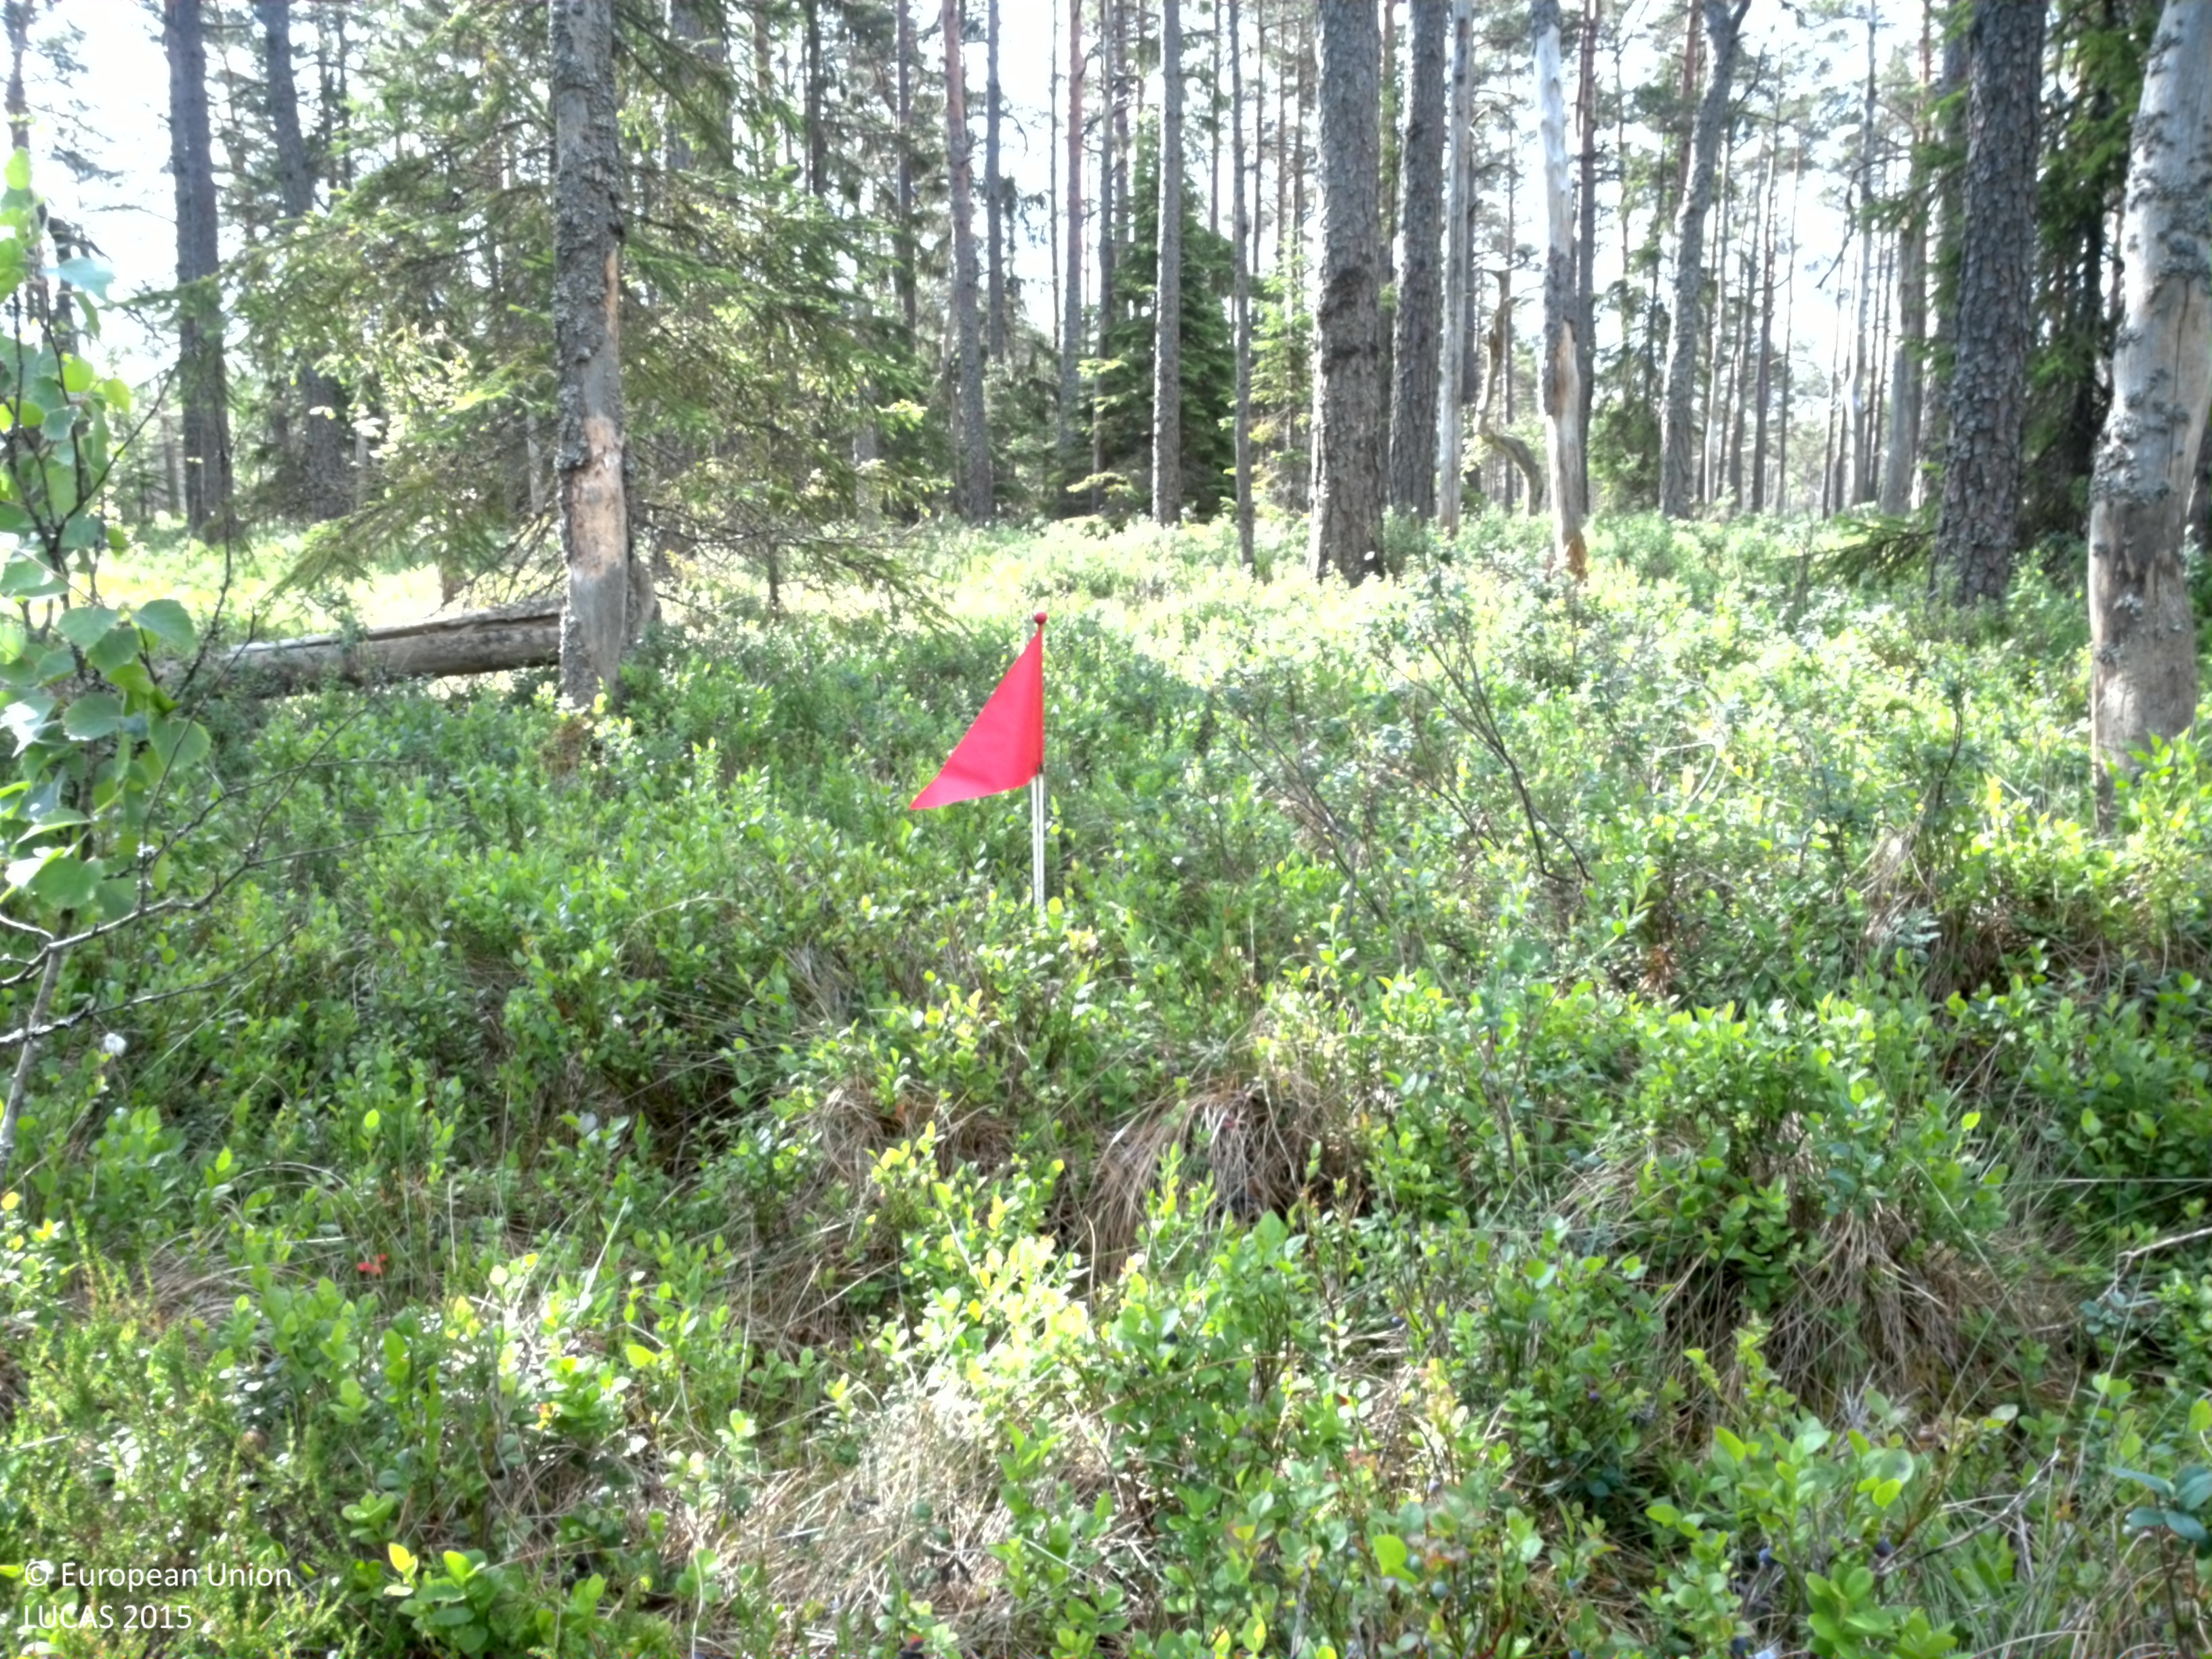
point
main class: Woodland
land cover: Pine dominated coniferous woodland
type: boreal forest
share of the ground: 50 - 75 %
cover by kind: coniferous forest trees 70 %, shrubs 15 %, lichens and mosses 15 %
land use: Forestry
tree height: > 5 m
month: July
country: SE
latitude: 57.5657
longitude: 14.5594
